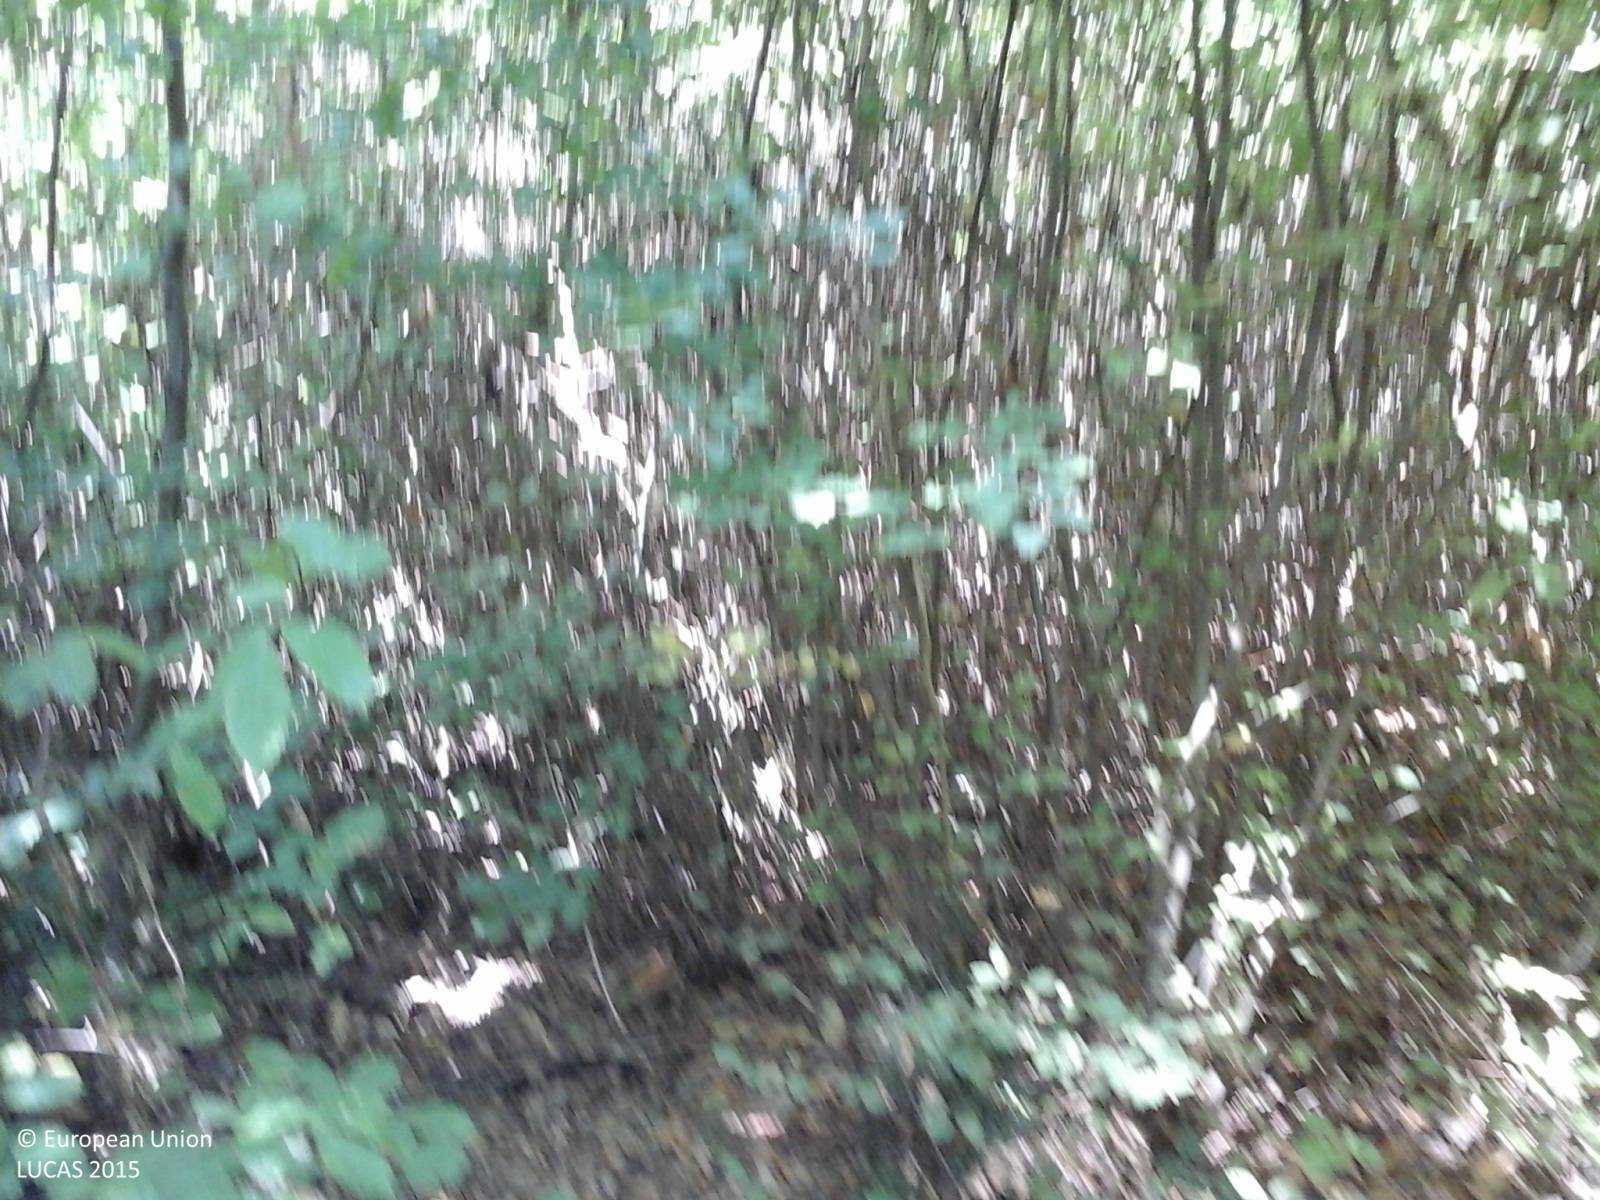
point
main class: Woodland
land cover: Broadleaved woodland
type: thermophilous deciduous forest
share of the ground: > 75 %
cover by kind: broadleaved forest trees 100 %
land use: Forestry
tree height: > 5 m
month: September
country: IT
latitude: 42.6550
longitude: 11.8603
